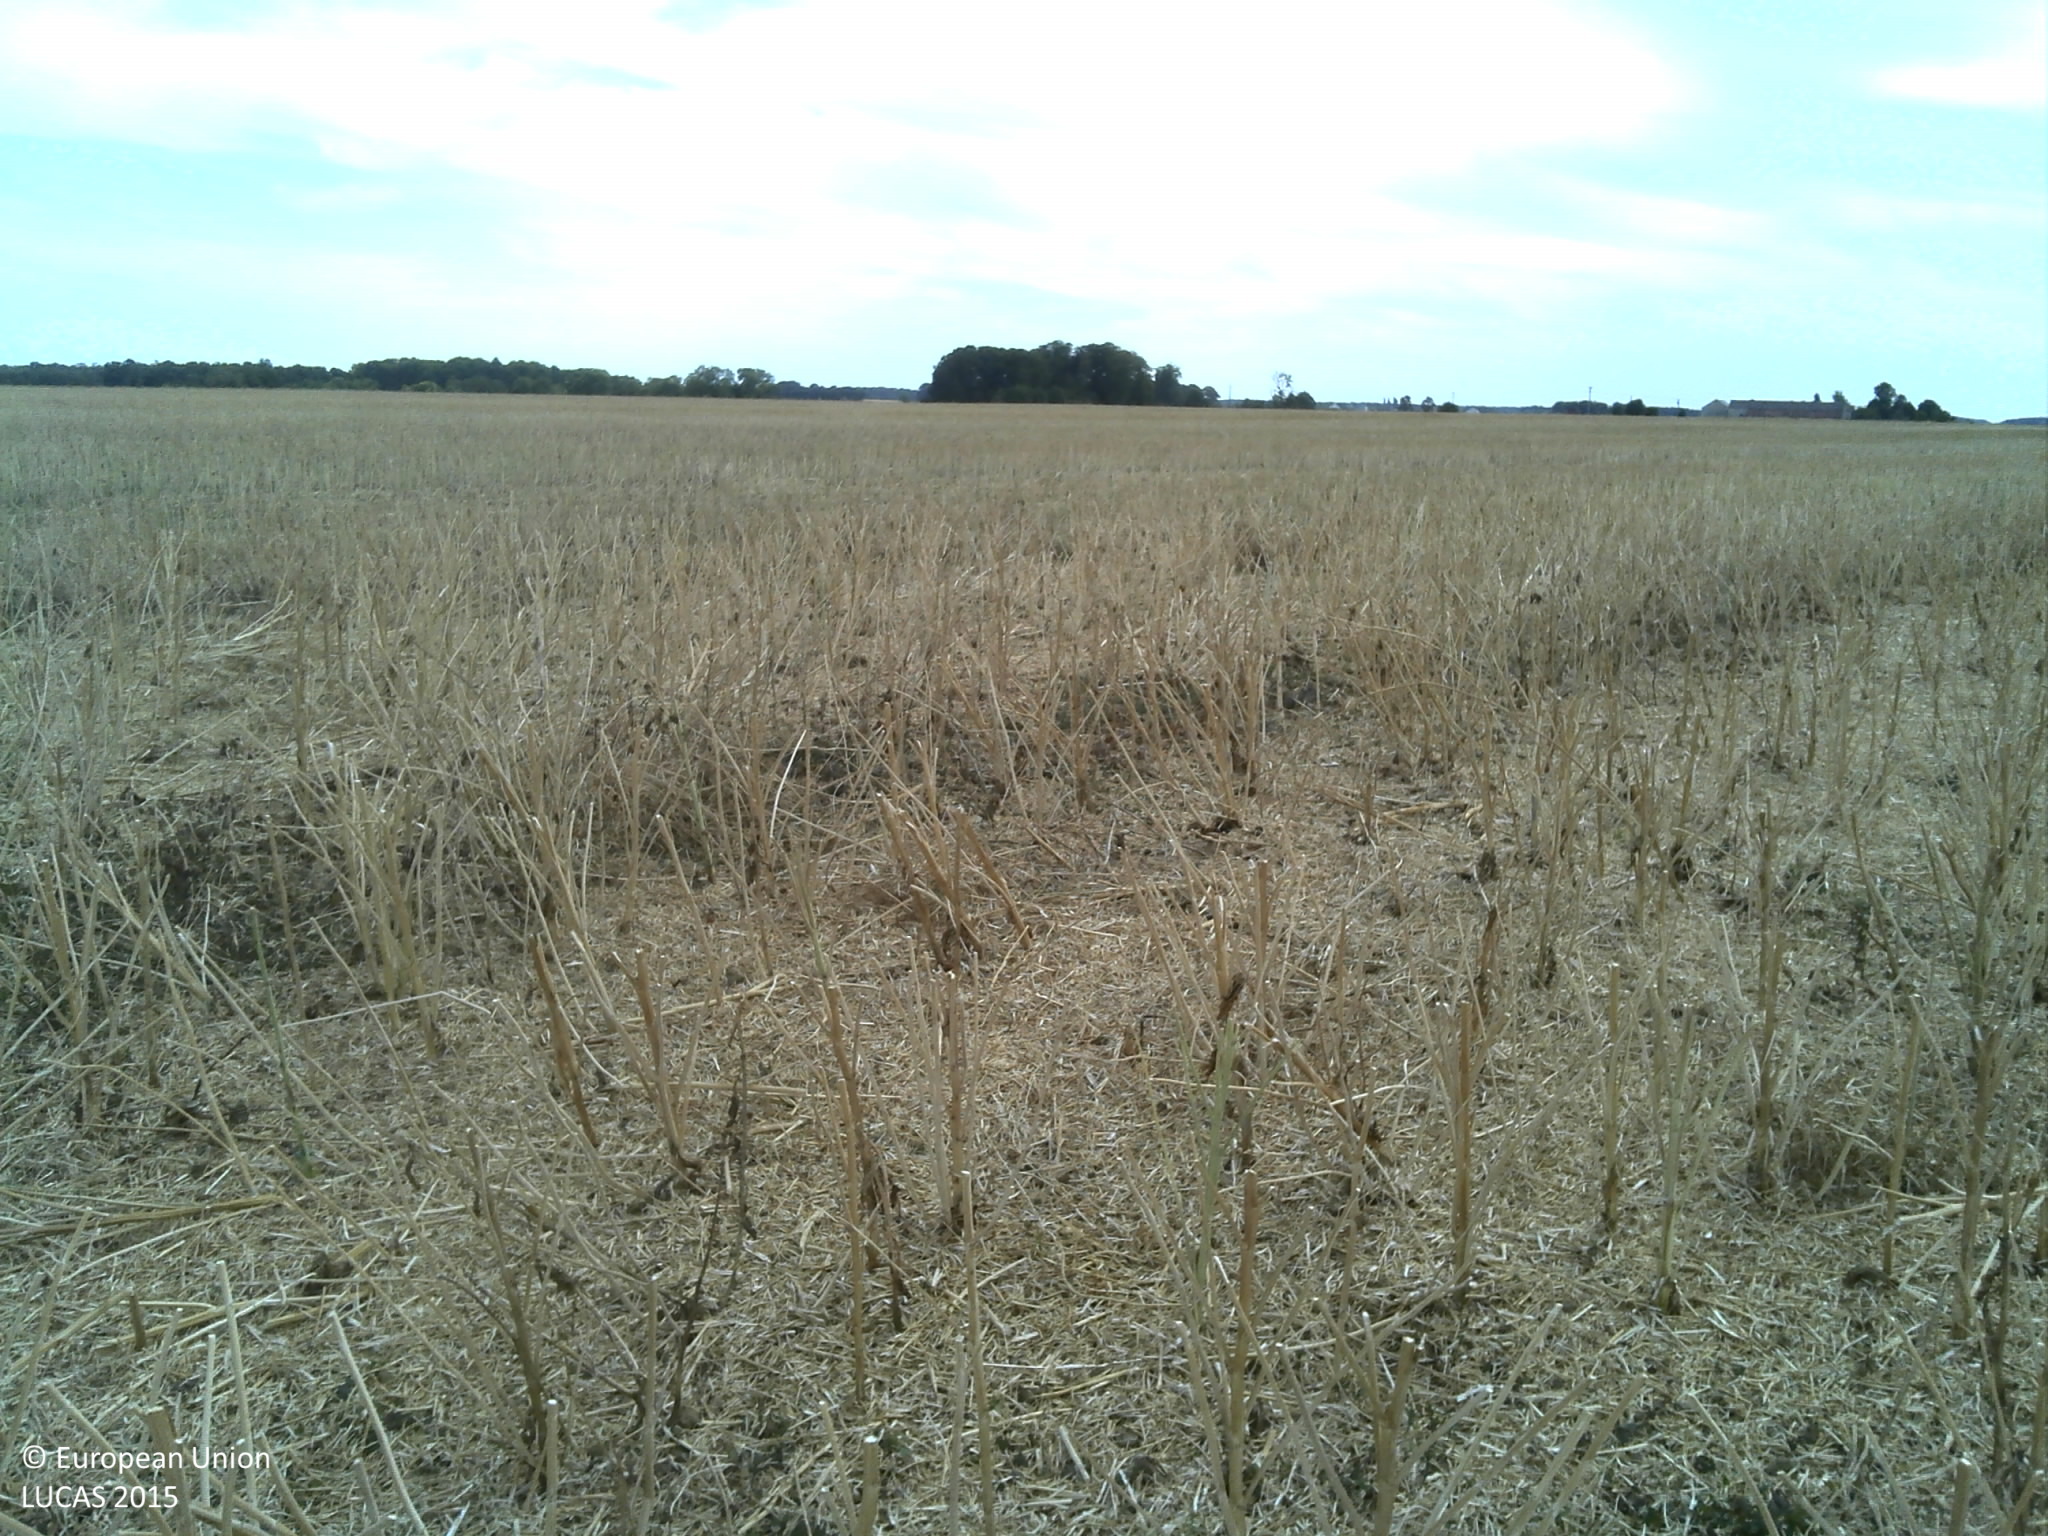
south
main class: Cropland
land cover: Rape and turnip rape
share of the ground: 25 - 50 %
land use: Agriculture (excluding fallow land and kitchen gardens)
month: August
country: FR
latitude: 48.5916
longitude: 1.8641
